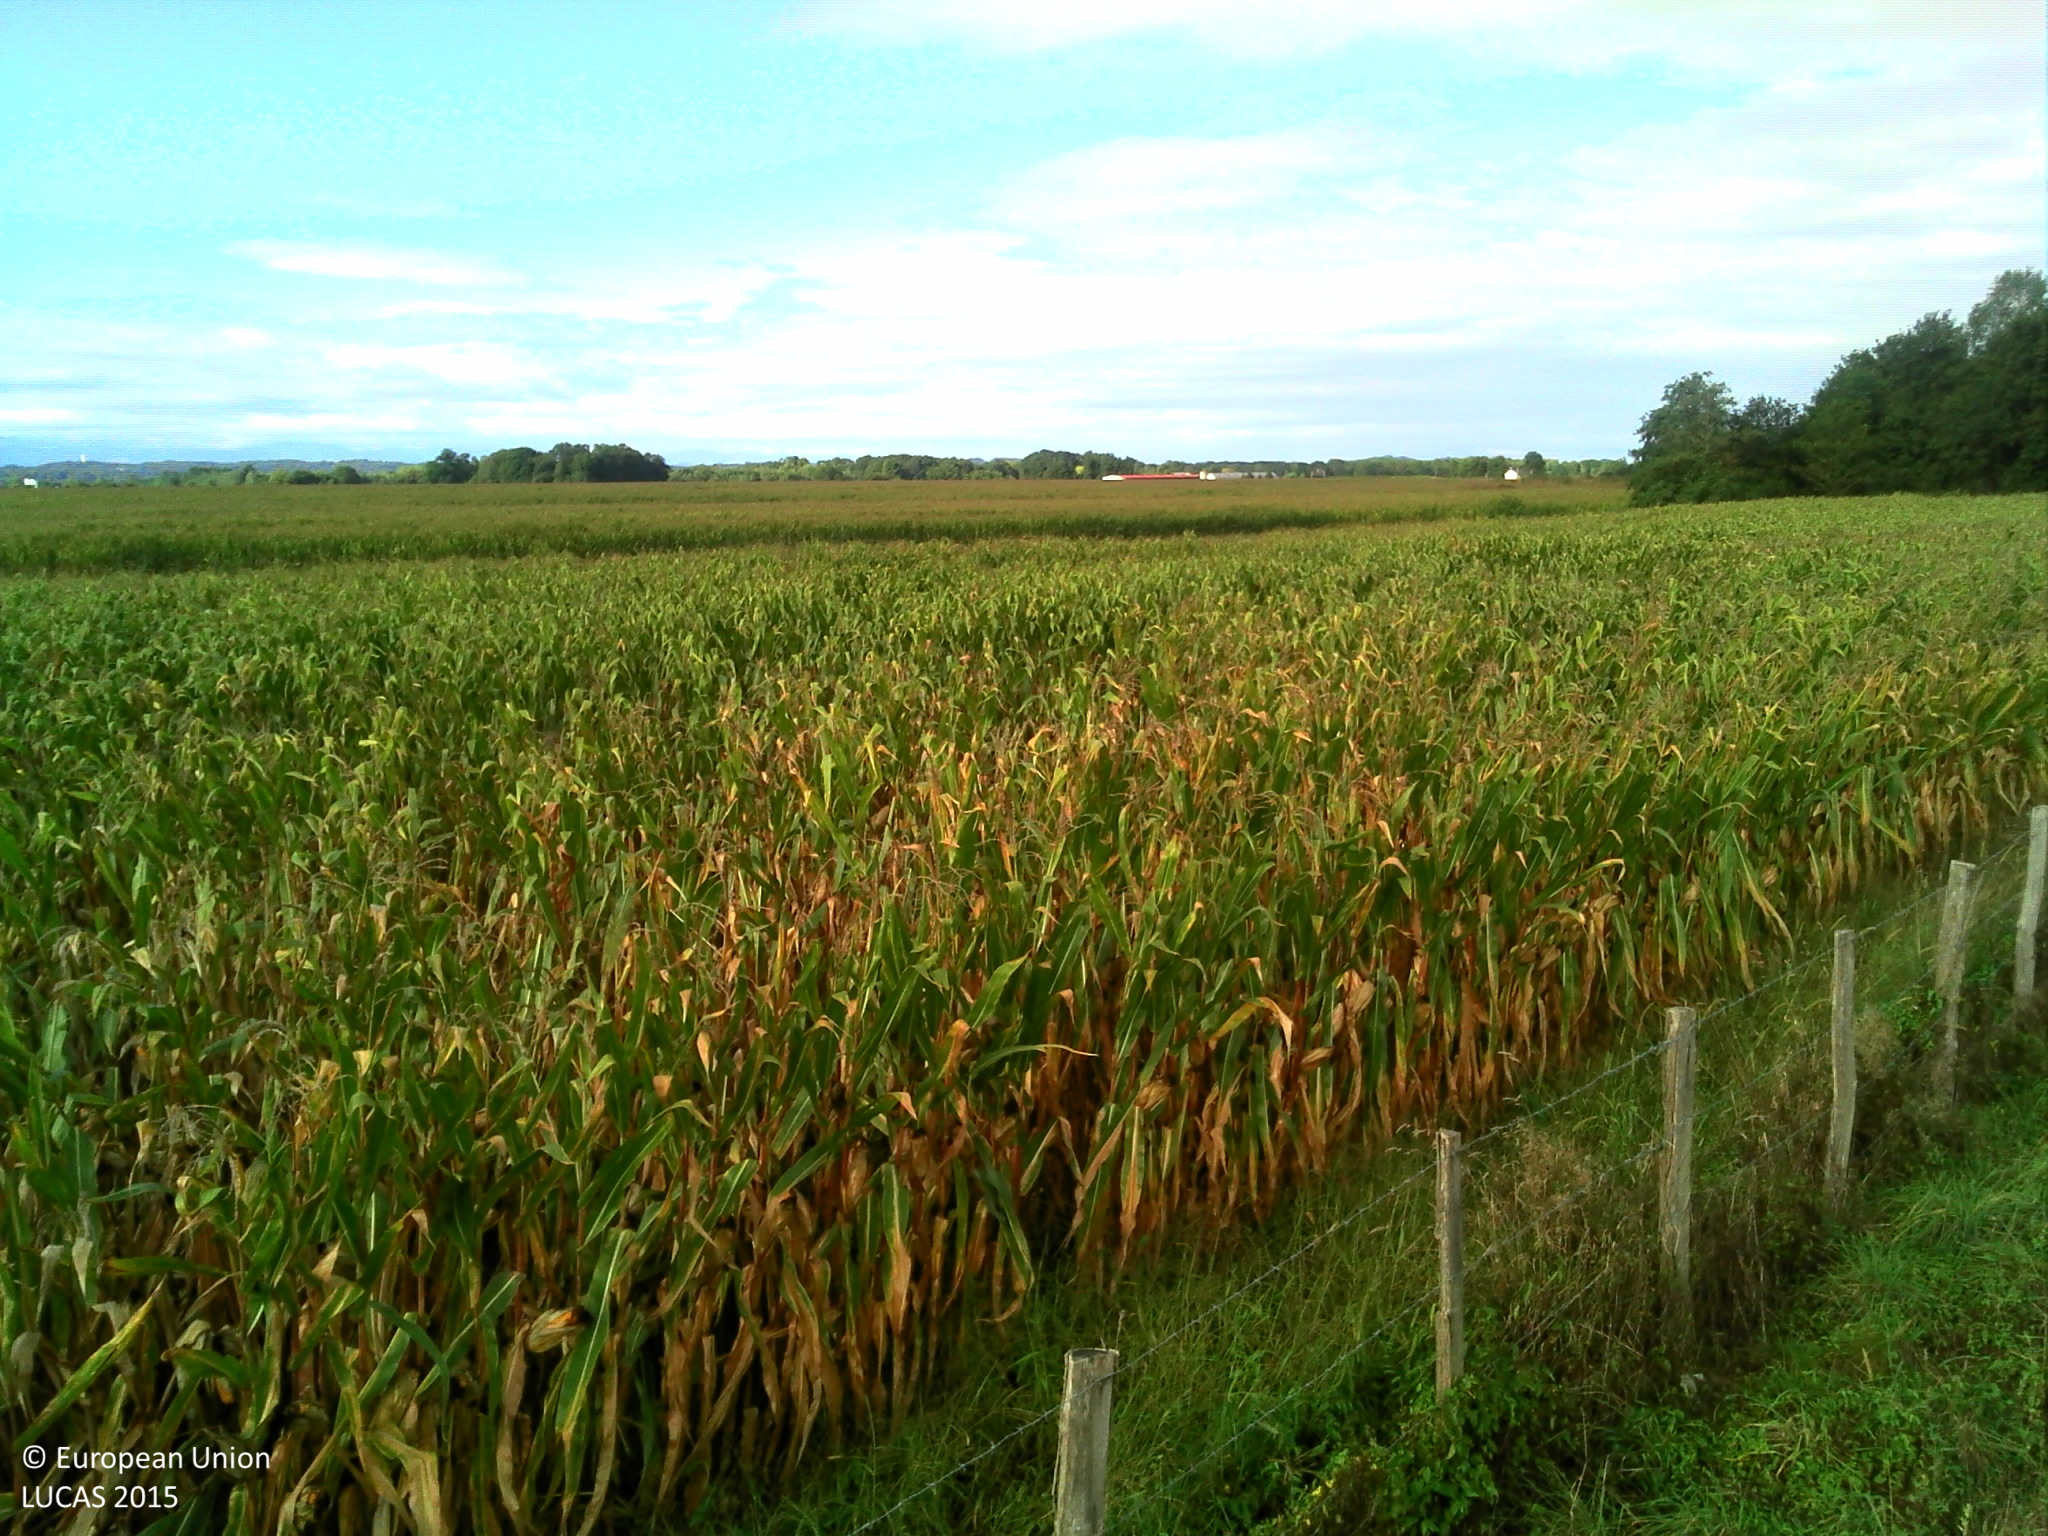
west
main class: Cropland
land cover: Maize
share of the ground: > 75 %
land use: Agriculture (excluding fallow land and kitchen gardens)
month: September
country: FR
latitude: 43.3532
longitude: -0.4081
